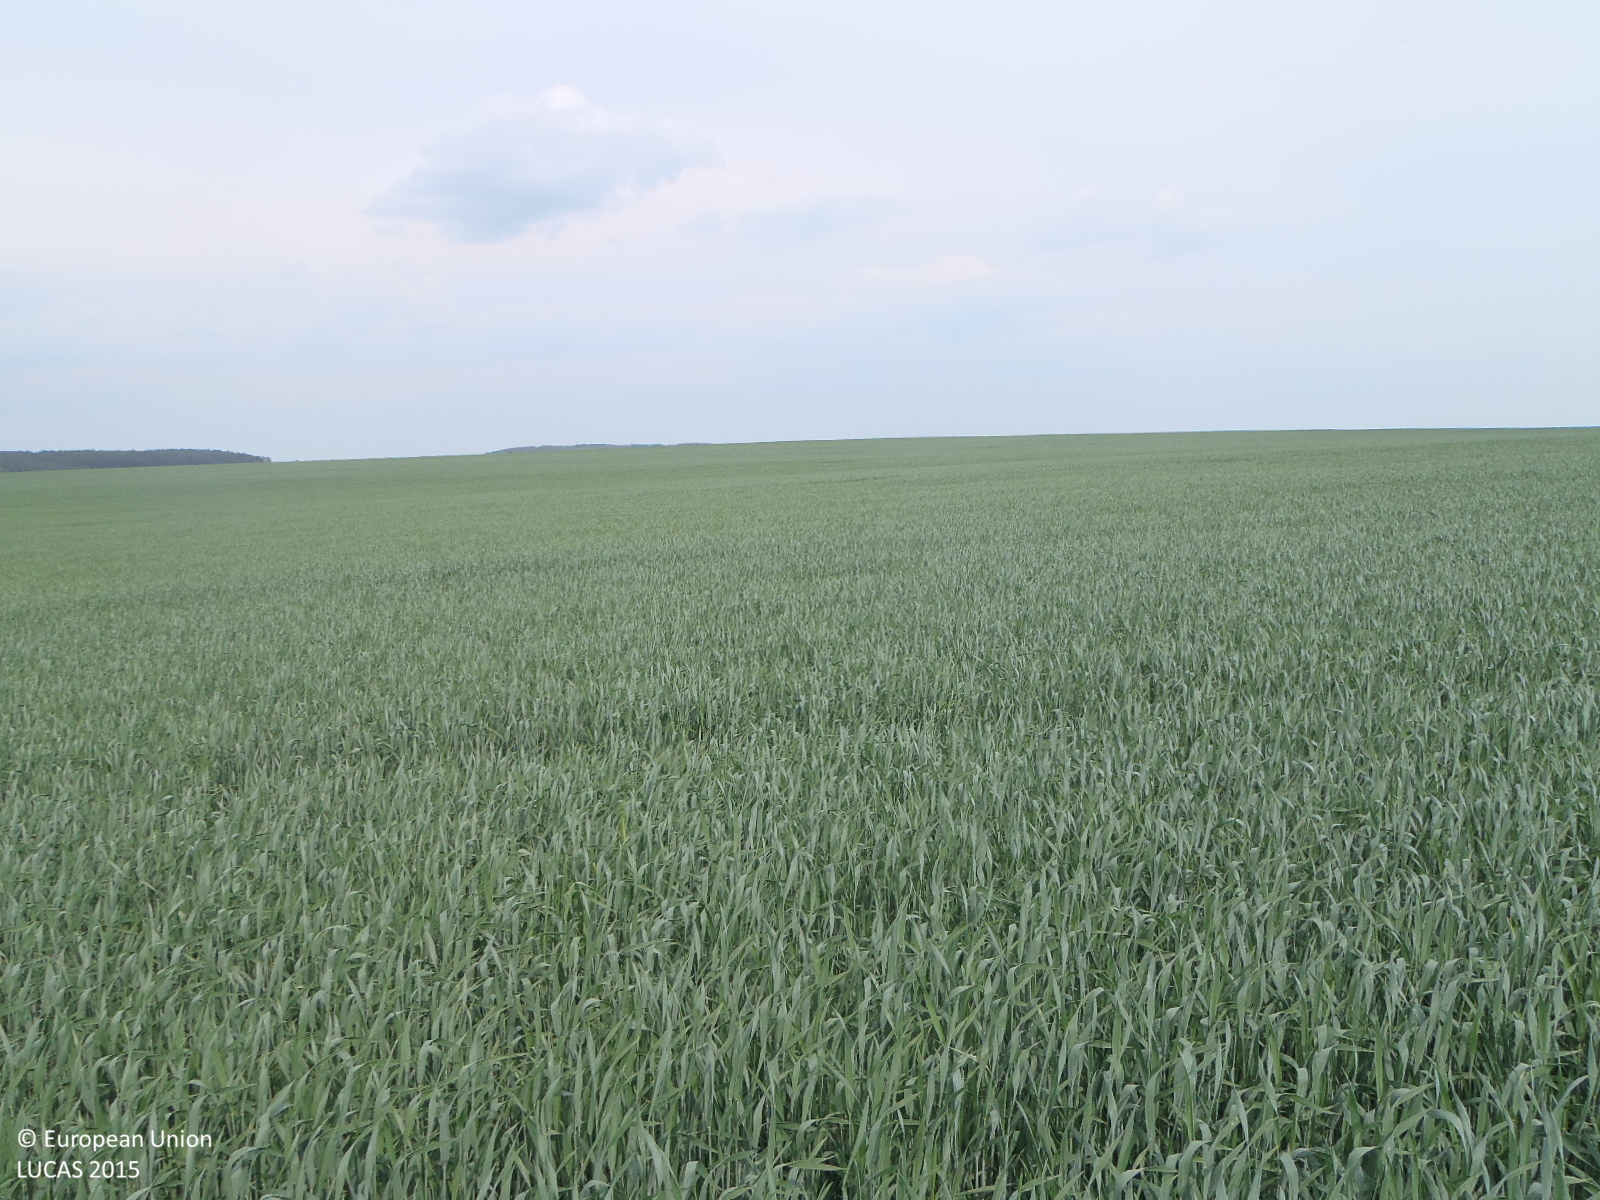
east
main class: Cropland
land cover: Common wheat
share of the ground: > 75 %
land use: Agriculture (excluding fallow land and kitchen gardens)
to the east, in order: Common wheat
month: May
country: CZ
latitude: 48.9847
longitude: 15.5650
